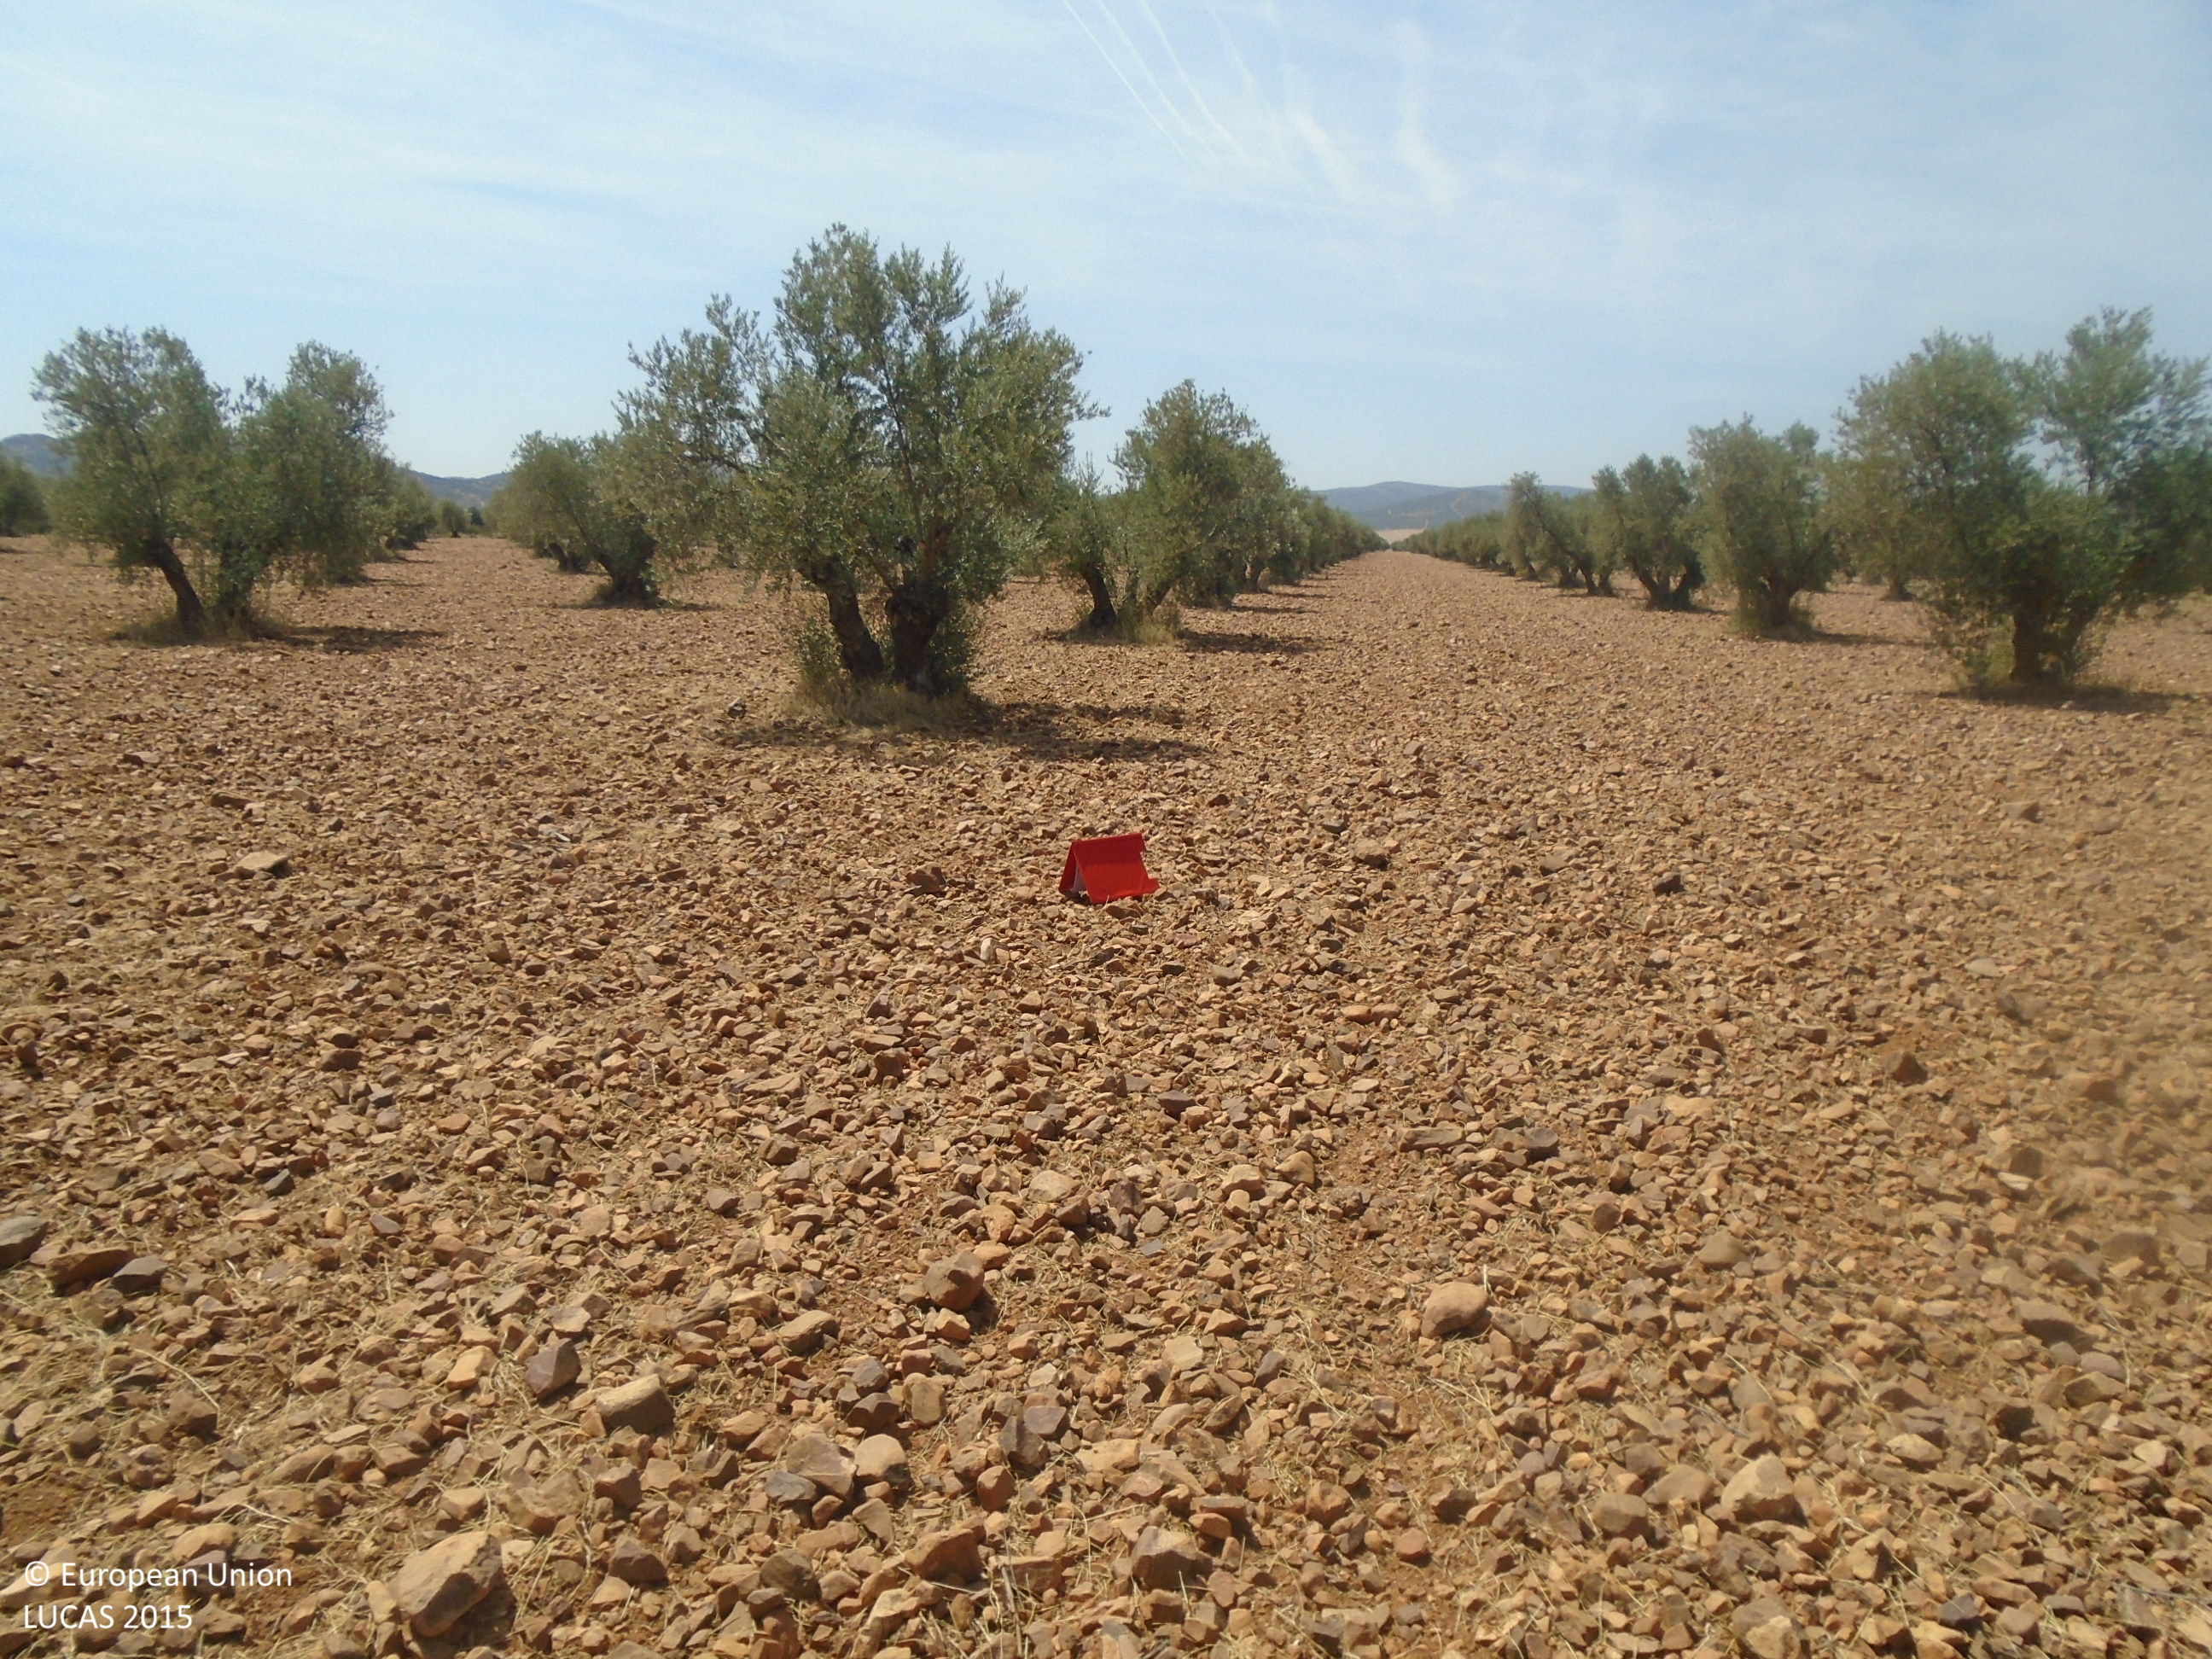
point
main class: Cropland
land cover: Olive groves
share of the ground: 25 - 50 %
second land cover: Other bare soil
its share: > 75 %
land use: Agriculture (excluding fallow land and kitchen gardens)
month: July
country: ES
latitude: 39.4072
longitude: -3.5988
